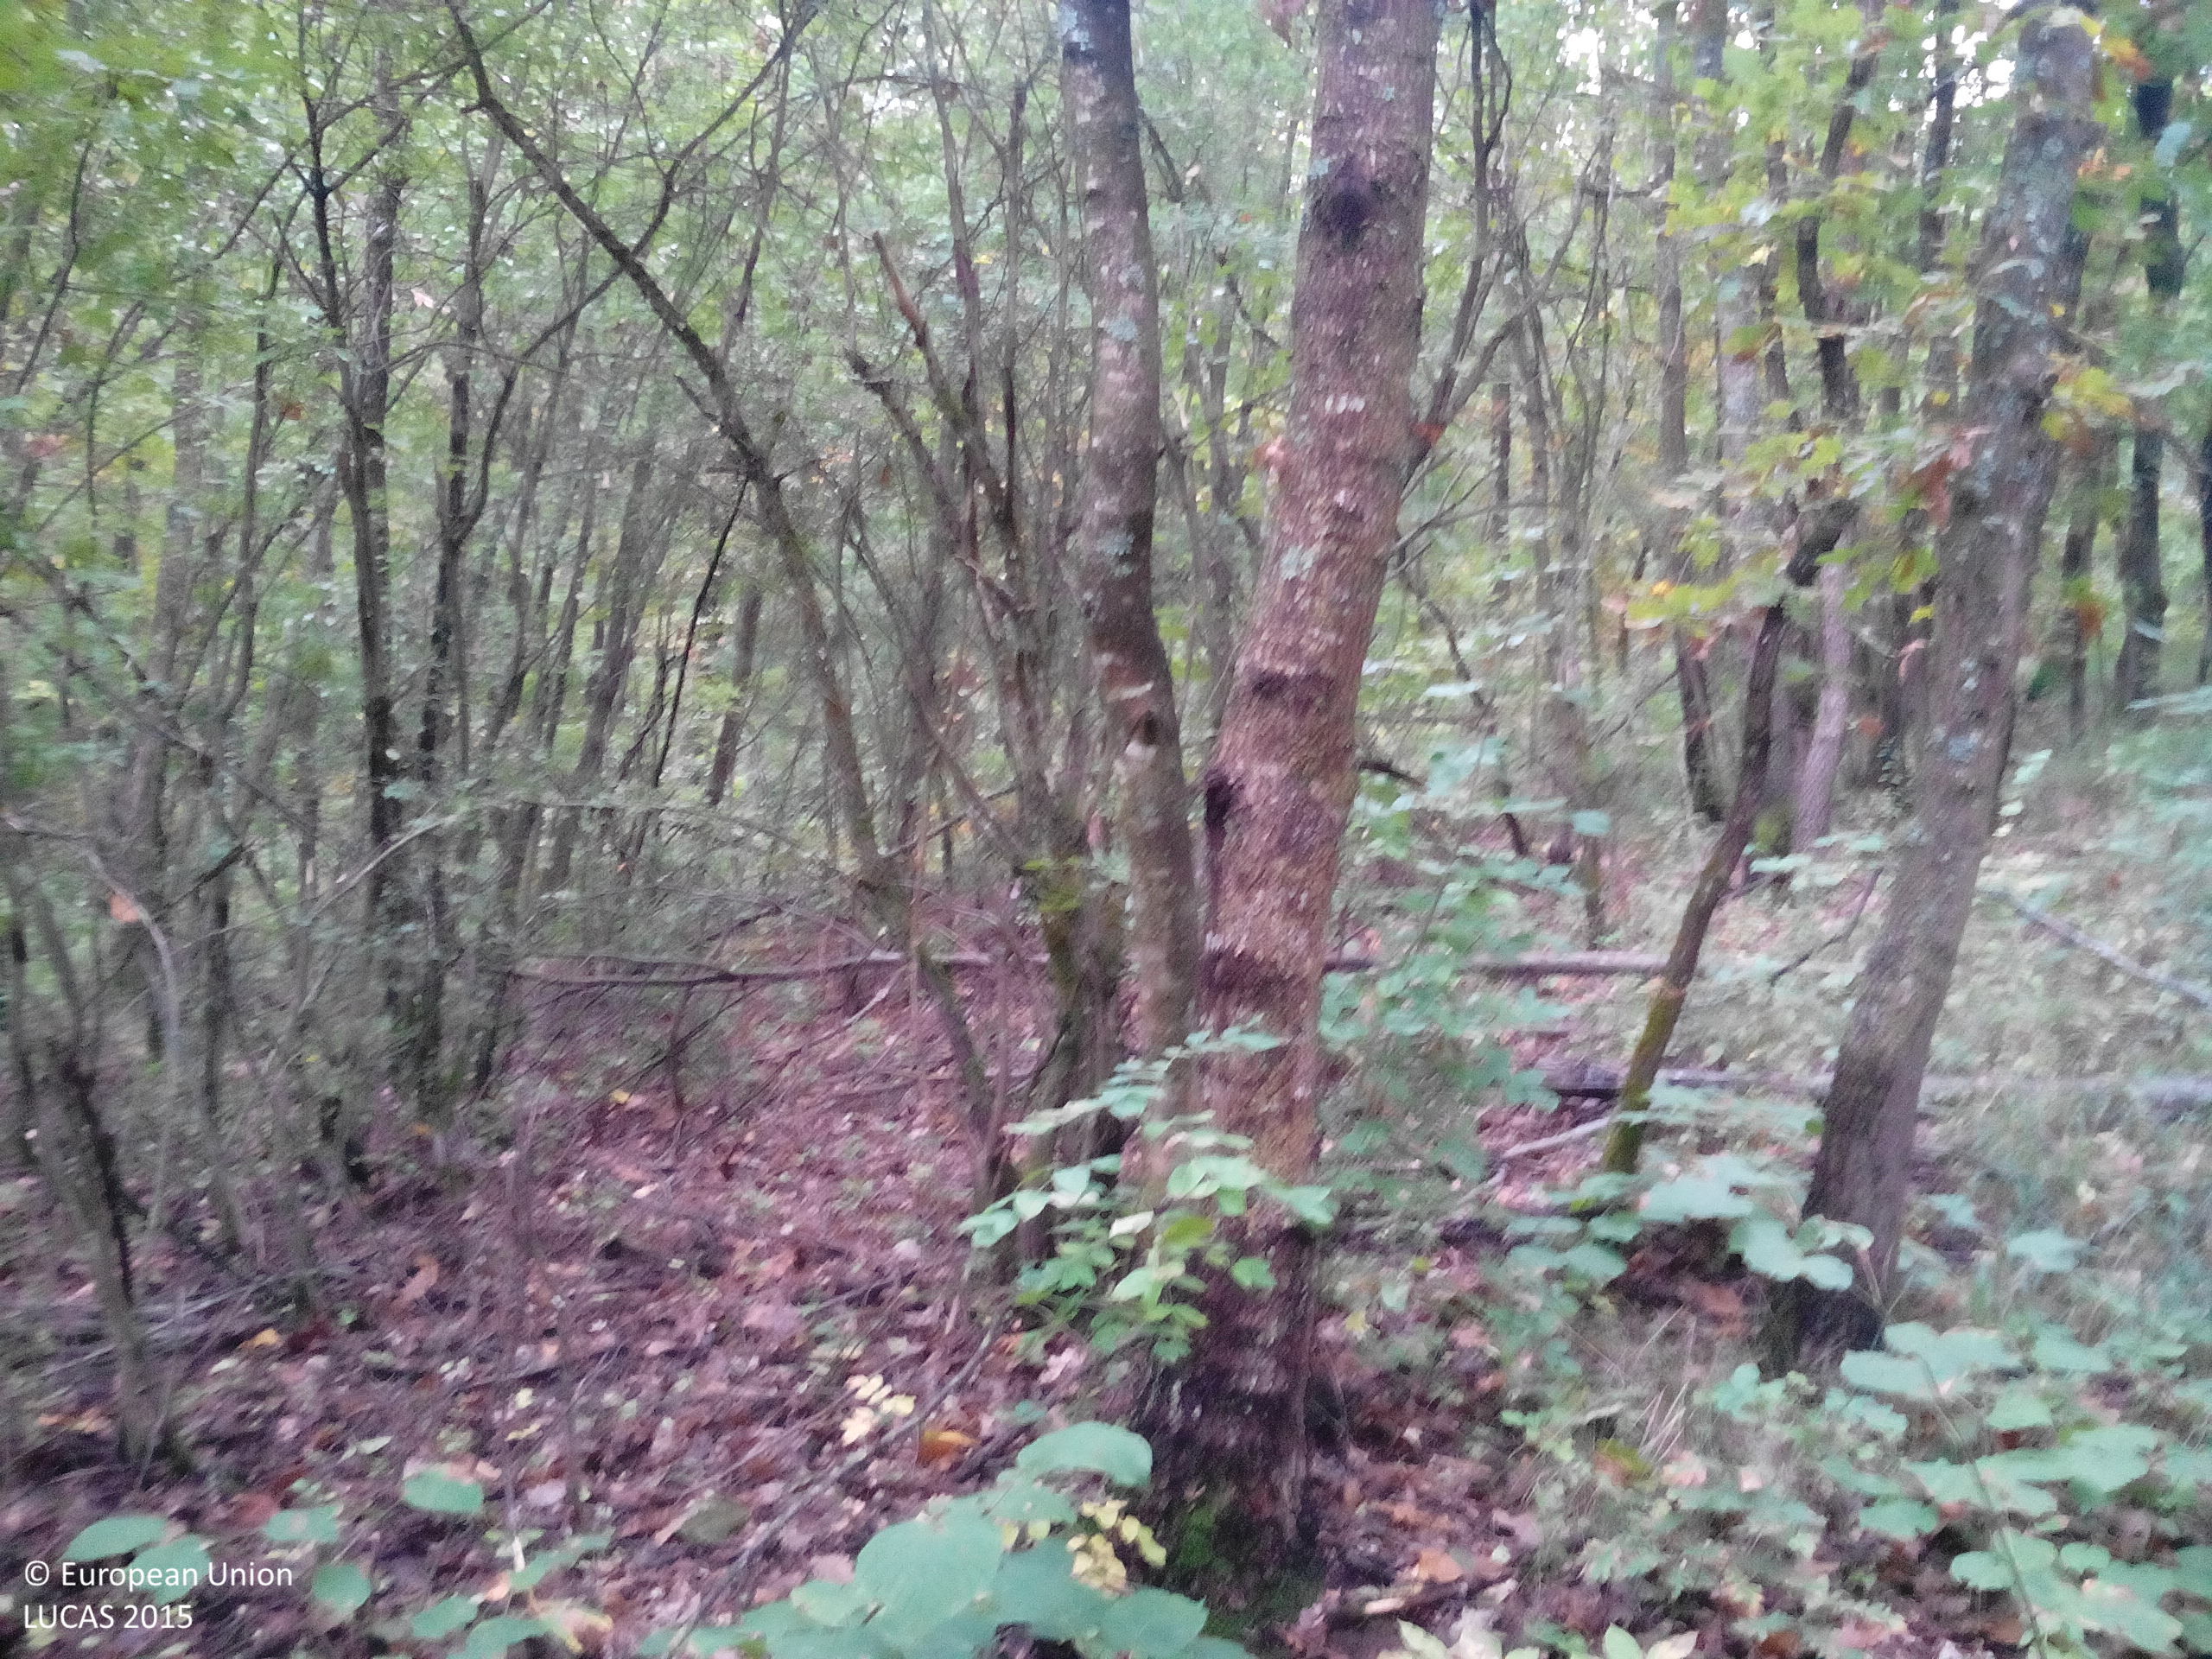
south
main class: Woodland
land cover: Broadleaved woodland
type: mesophytic deciduous forest
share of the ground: > 75 %
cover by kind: broadleaved forest trees 90 %, shrubs 5 %, herbaceous plants 5 %
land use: Forestry
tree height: > 5 m
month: October
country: BG
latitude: 43.1285
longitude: 23.9510
